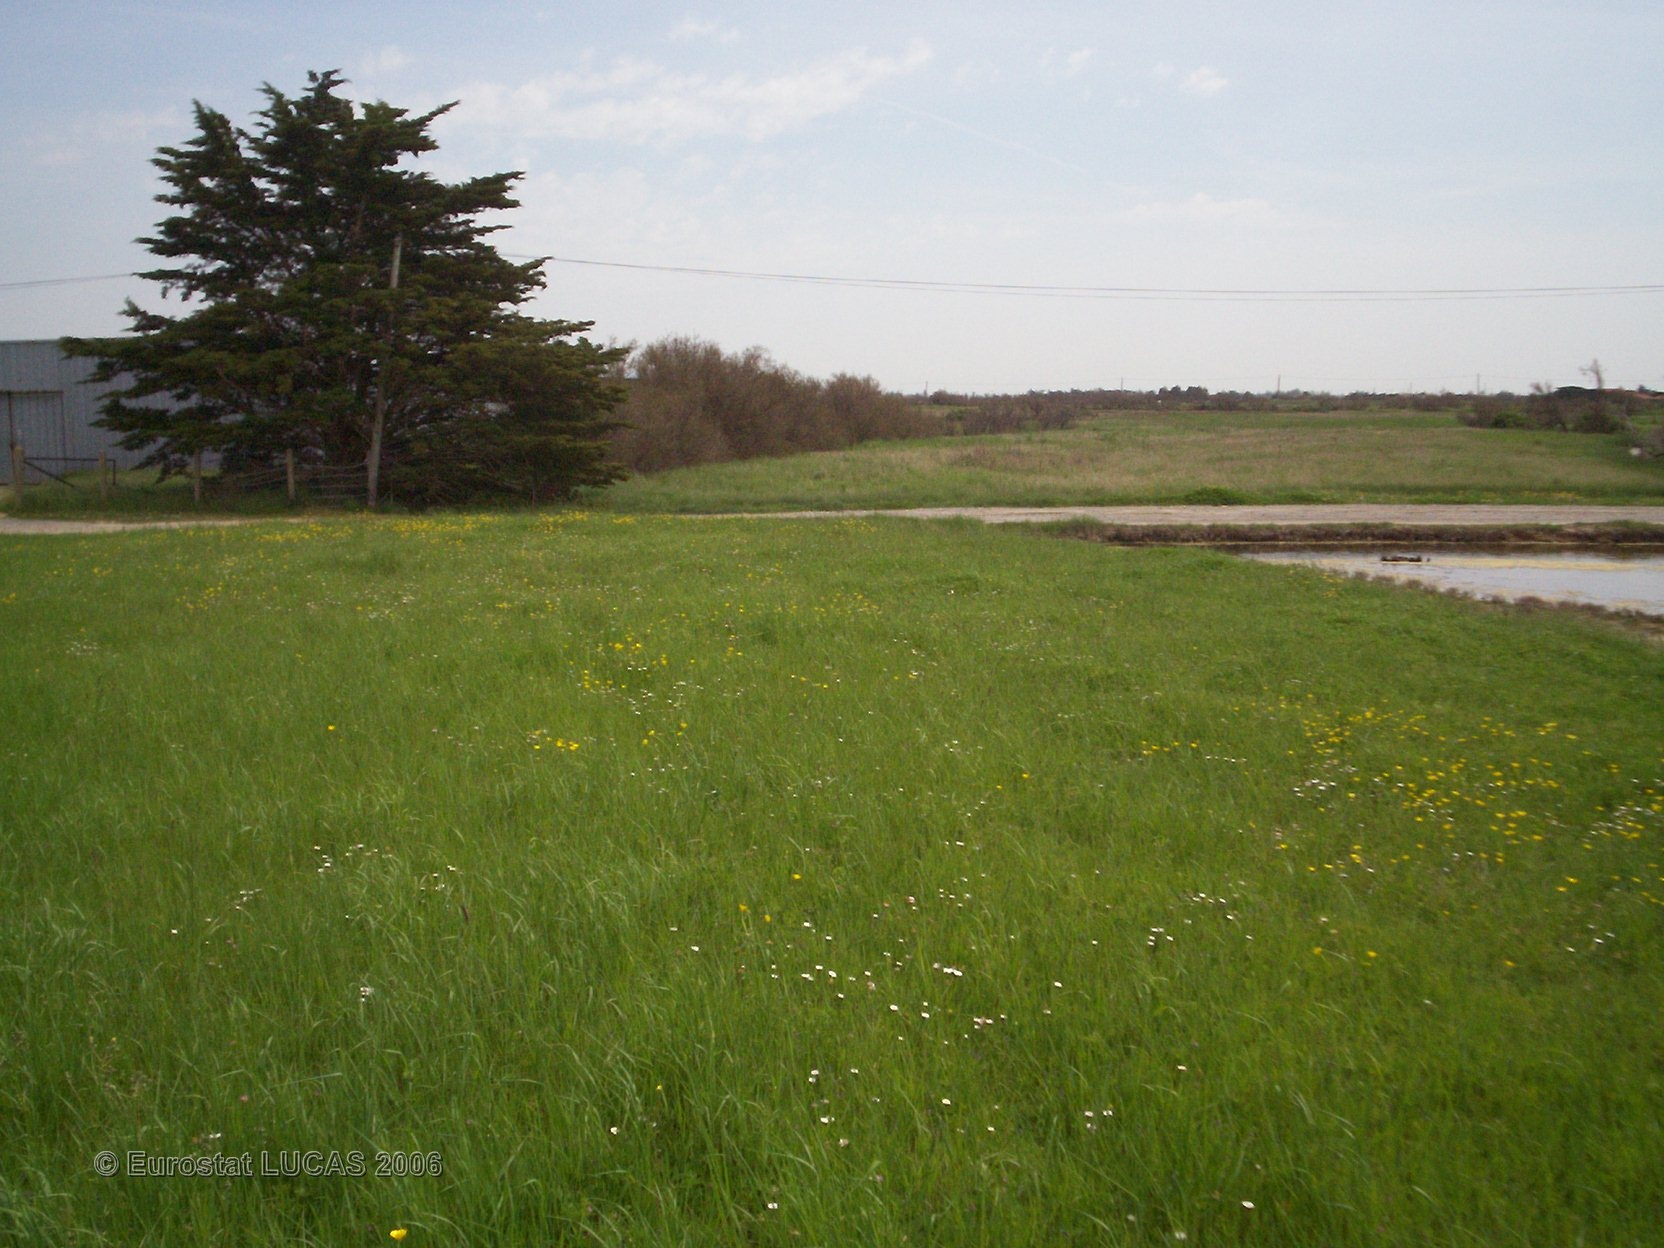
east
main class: Grassland
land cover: Grassland without tree/shrub cover
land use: Agriculture (excluding fallow land and kitchen gardens)
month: May
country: FR
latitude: 46.8624
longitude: -2.1028
